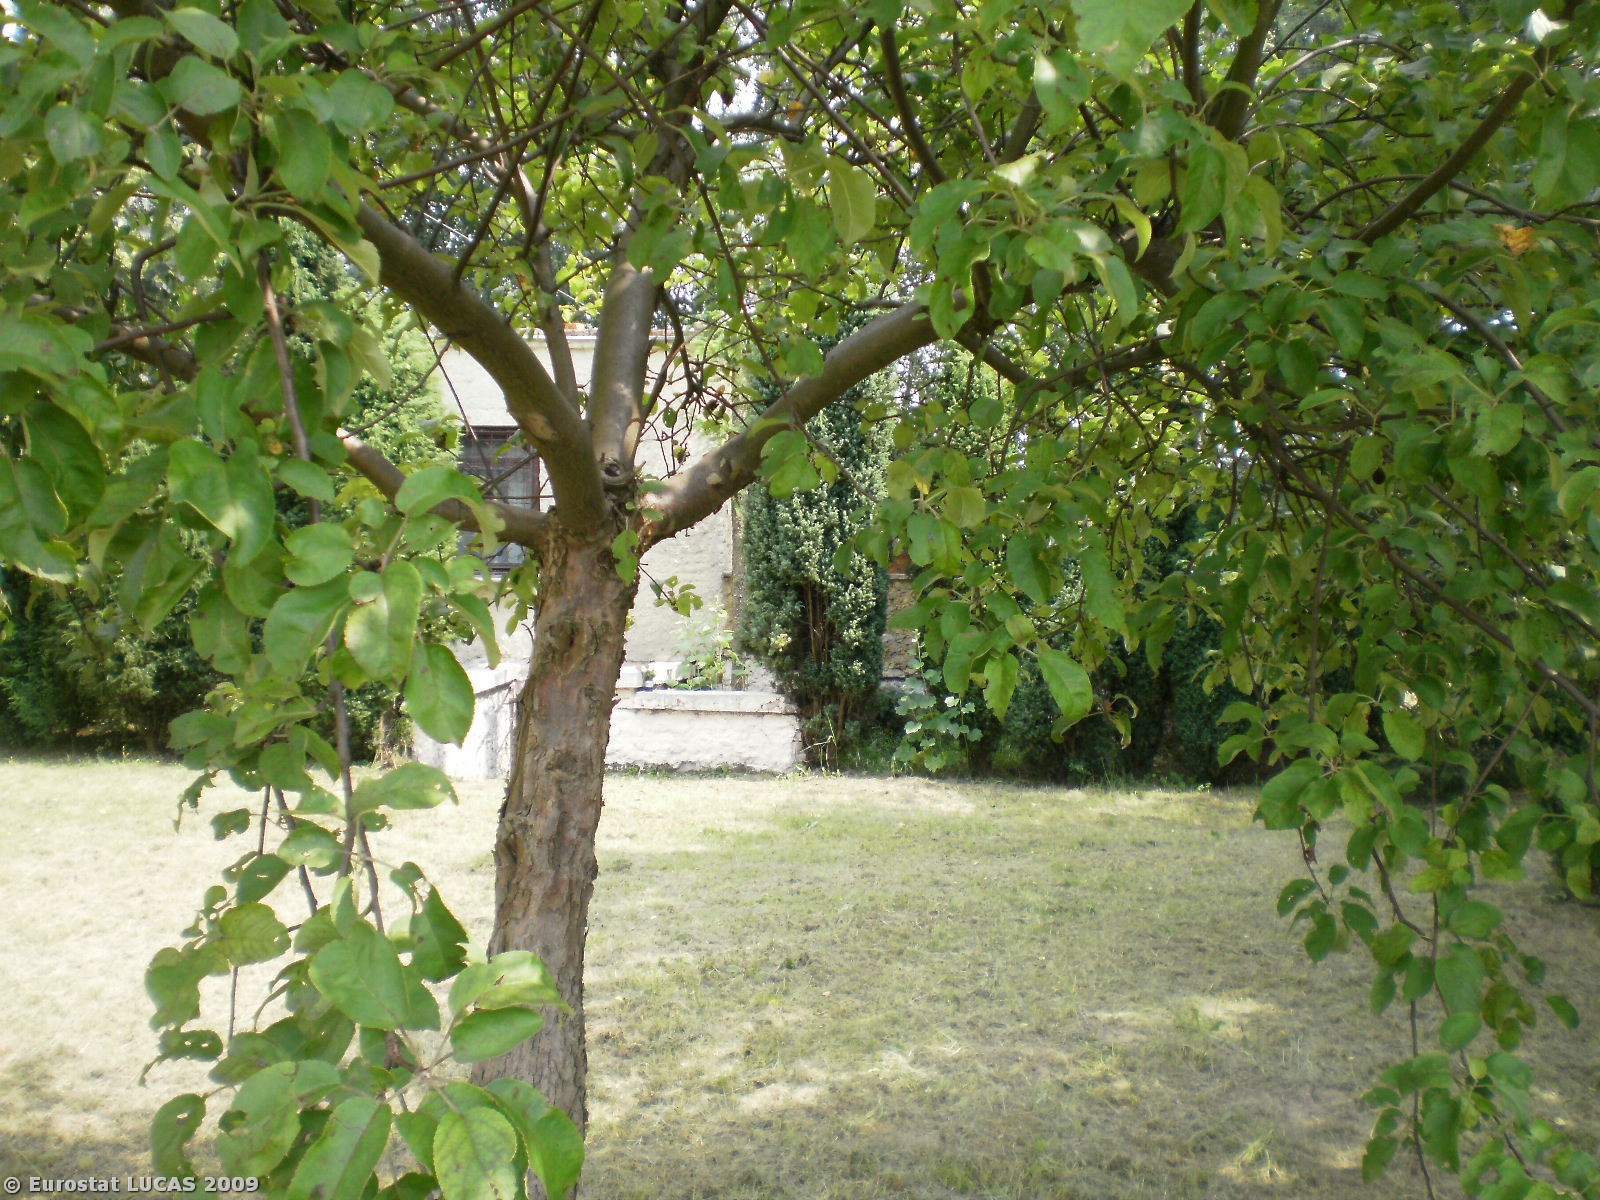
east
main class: Cropland
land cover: Apple fruit
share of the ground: 50 - 75 %
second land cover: Grassland with sparse tree/shrub cover
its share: 50 - 75 %
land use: Kitchen garden
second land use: Residential
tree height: < 5 m
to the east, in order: Apple fruit; Artificial constructions in urban areas; Fences; Rye; Fences; Grassland with sparse tree/shrub cover; Fences; Grassland with sparse tree/shrub cover; Tracks; Grassland with sparse tree/shrub cover
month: July
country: PL
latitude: 52.6083
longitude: 20.8070
